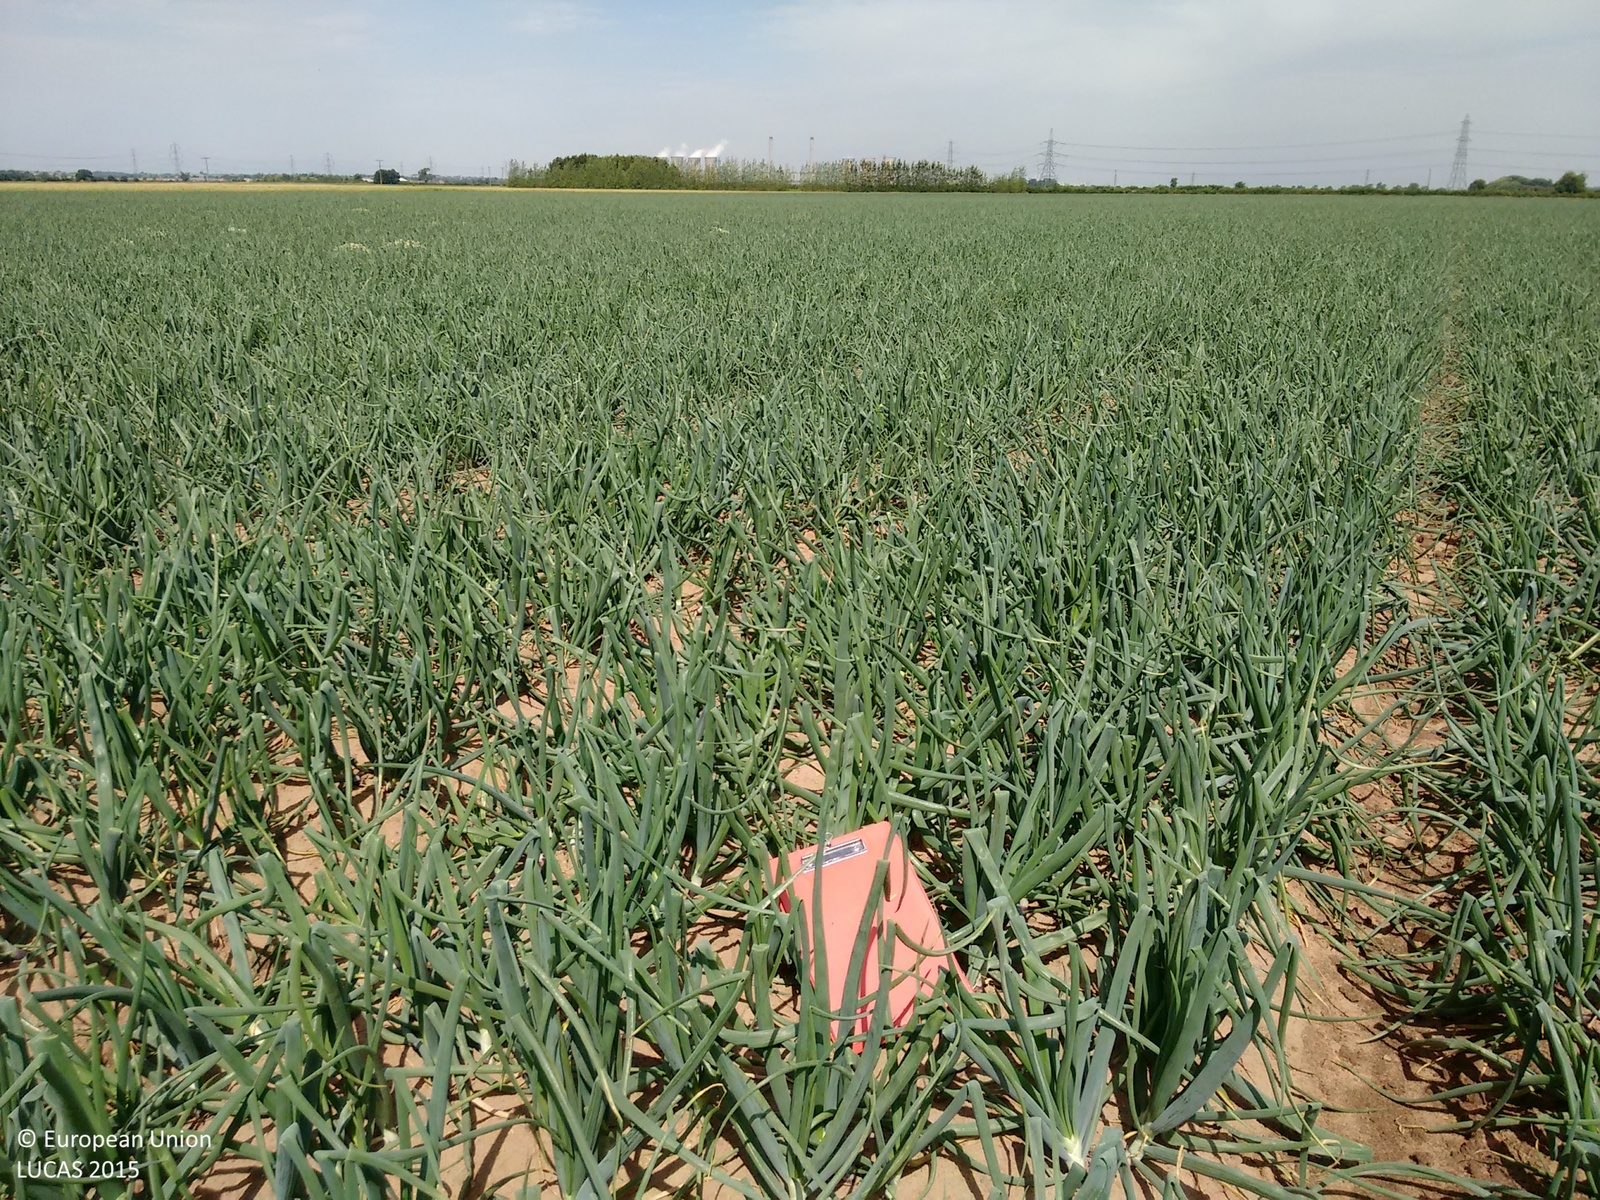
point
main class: Cropland
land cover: Other root crops
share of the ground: > 75 %
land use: Agriculture (excluding fallow land and kitchen gardens)
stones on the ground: < 10 %
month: July
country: GB
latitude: 53.3189
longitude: -0.7740
